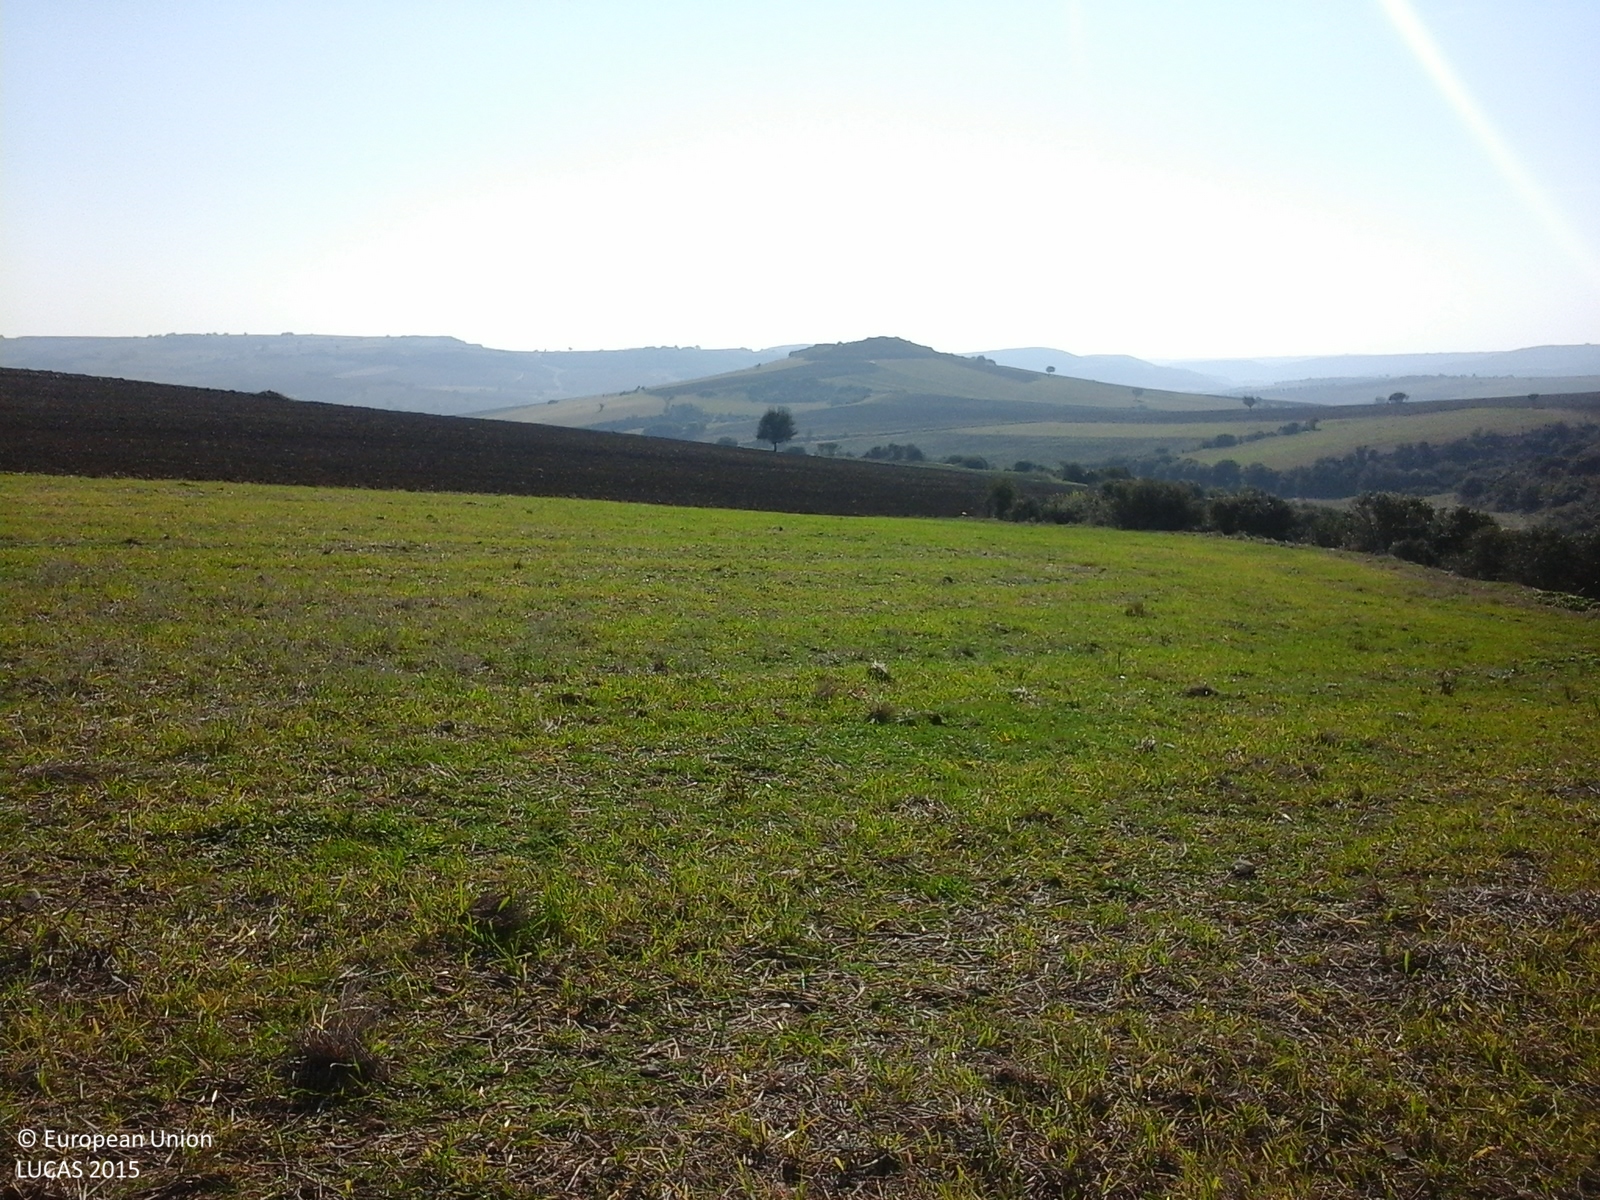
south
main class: Grassland
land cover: Spontaneously vegetated surfaces
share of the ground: > 75 %
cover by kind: herbaceous plants 100 %
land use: Agriculture (excluding fallow land and kitchen gardens)
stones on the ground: < 10 %
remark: Harvested field
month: November
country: GR
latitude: 40.4036
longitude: 23.1447
